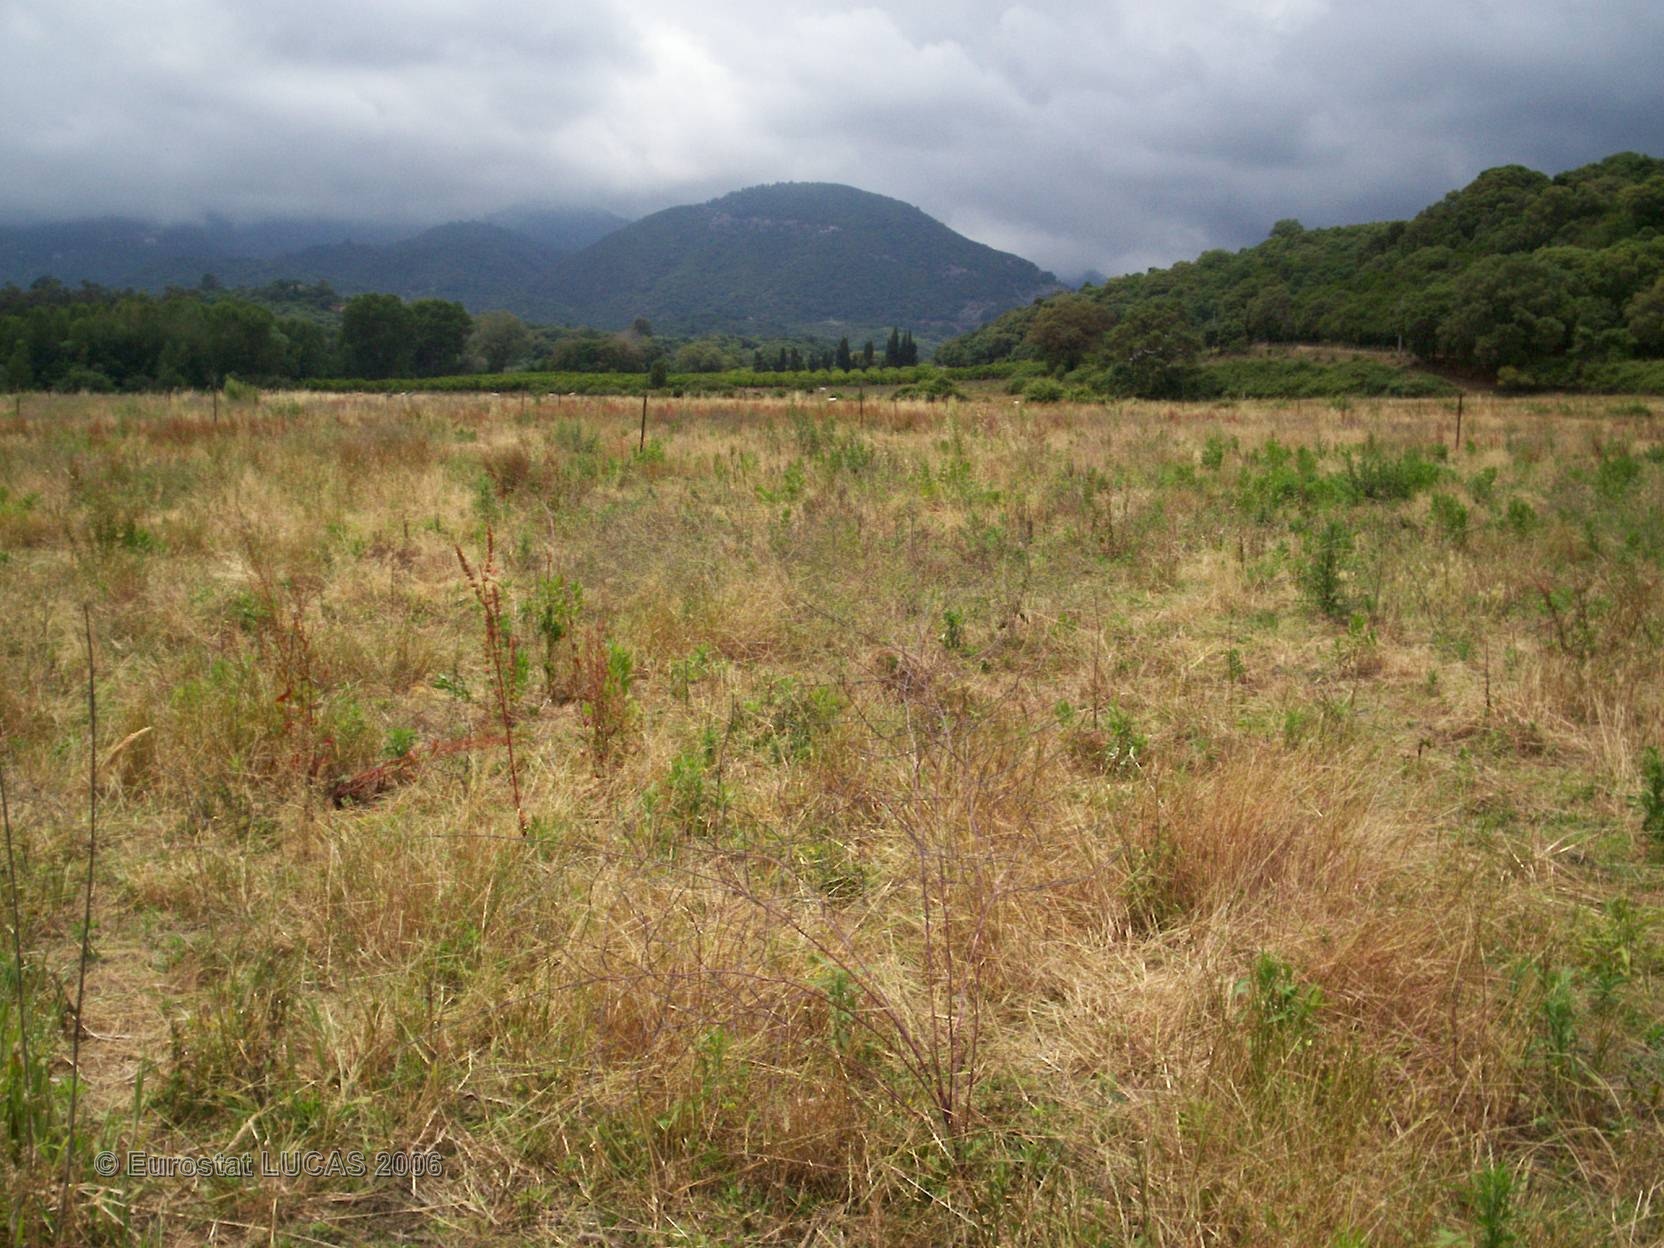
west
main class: Grassland
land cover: Grassland without tree/shrub cover
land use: Agriculture (excluding fallow land and kitchen gardens)
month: June
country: FR
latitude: 42.2916
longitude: 9.5287
